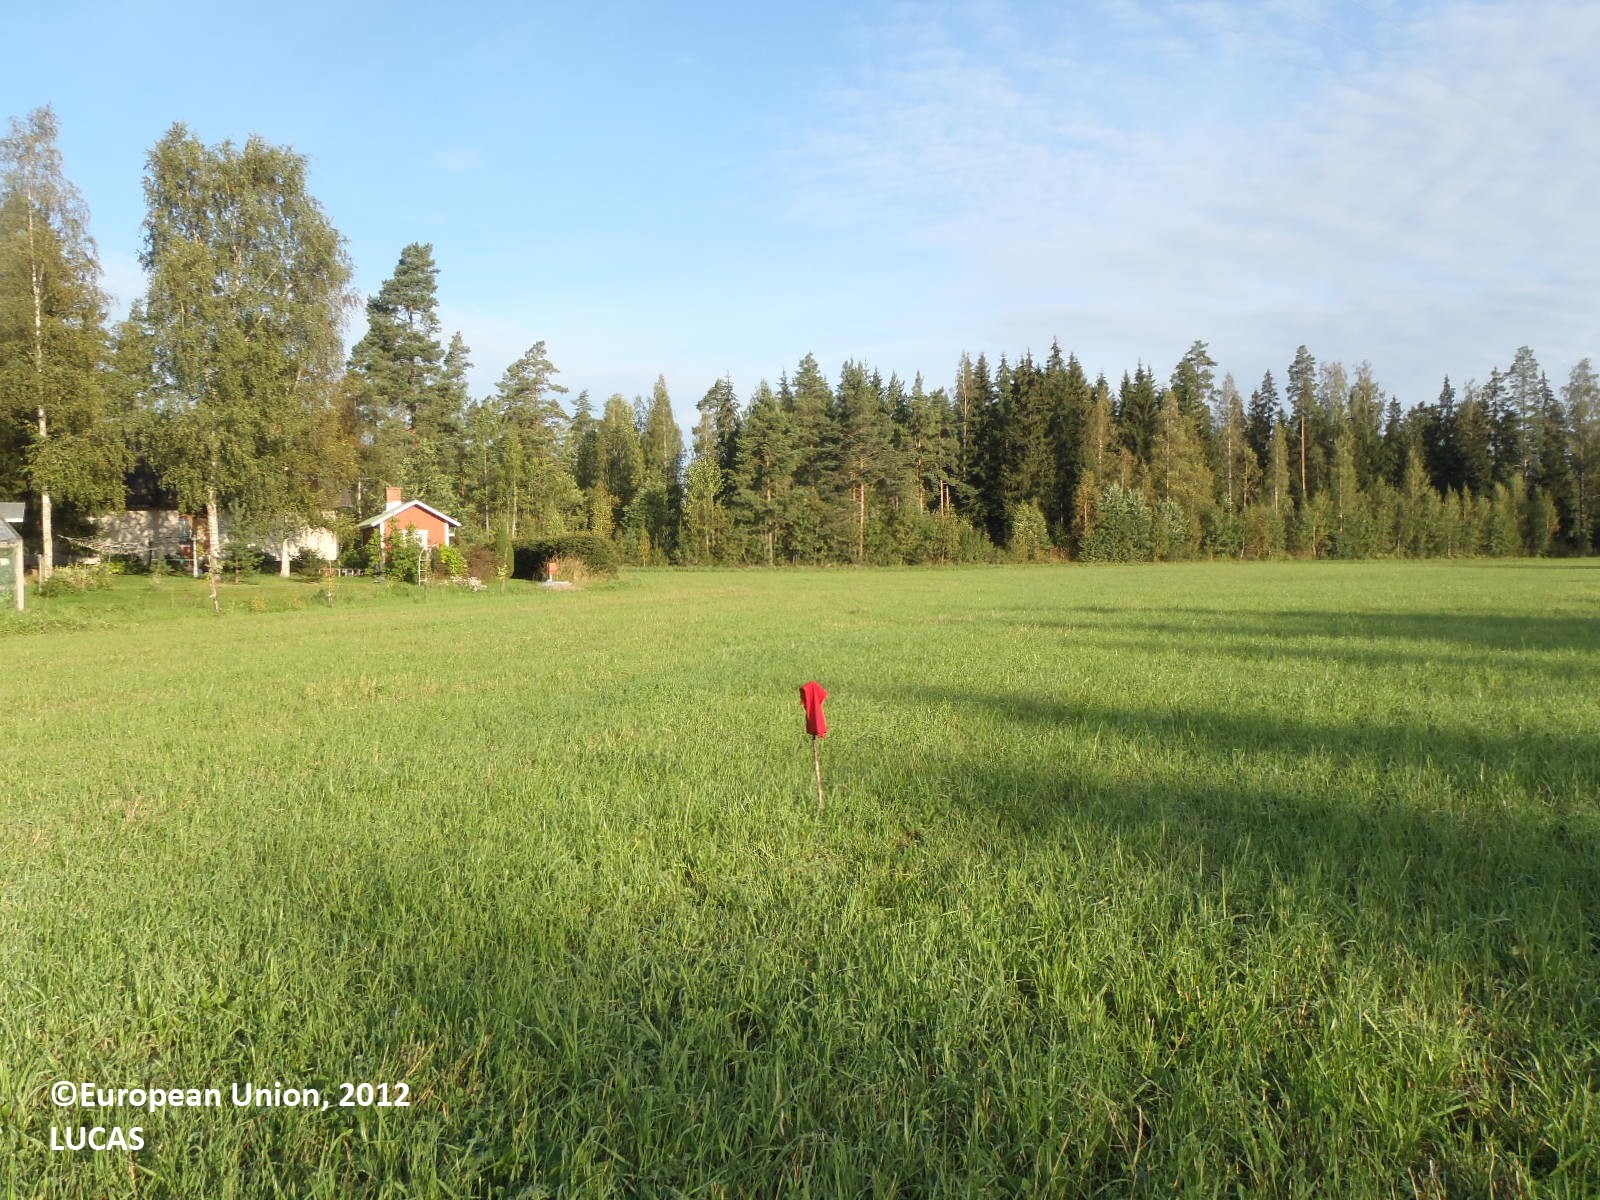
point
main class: Cropland
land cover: Temporary grasslands
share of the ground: > 75 %
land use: Agriculture (excluding fallow land and kitchen gardens)
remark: Harvested field
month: August
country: FI
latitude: 60.8081
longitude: 22.5117
